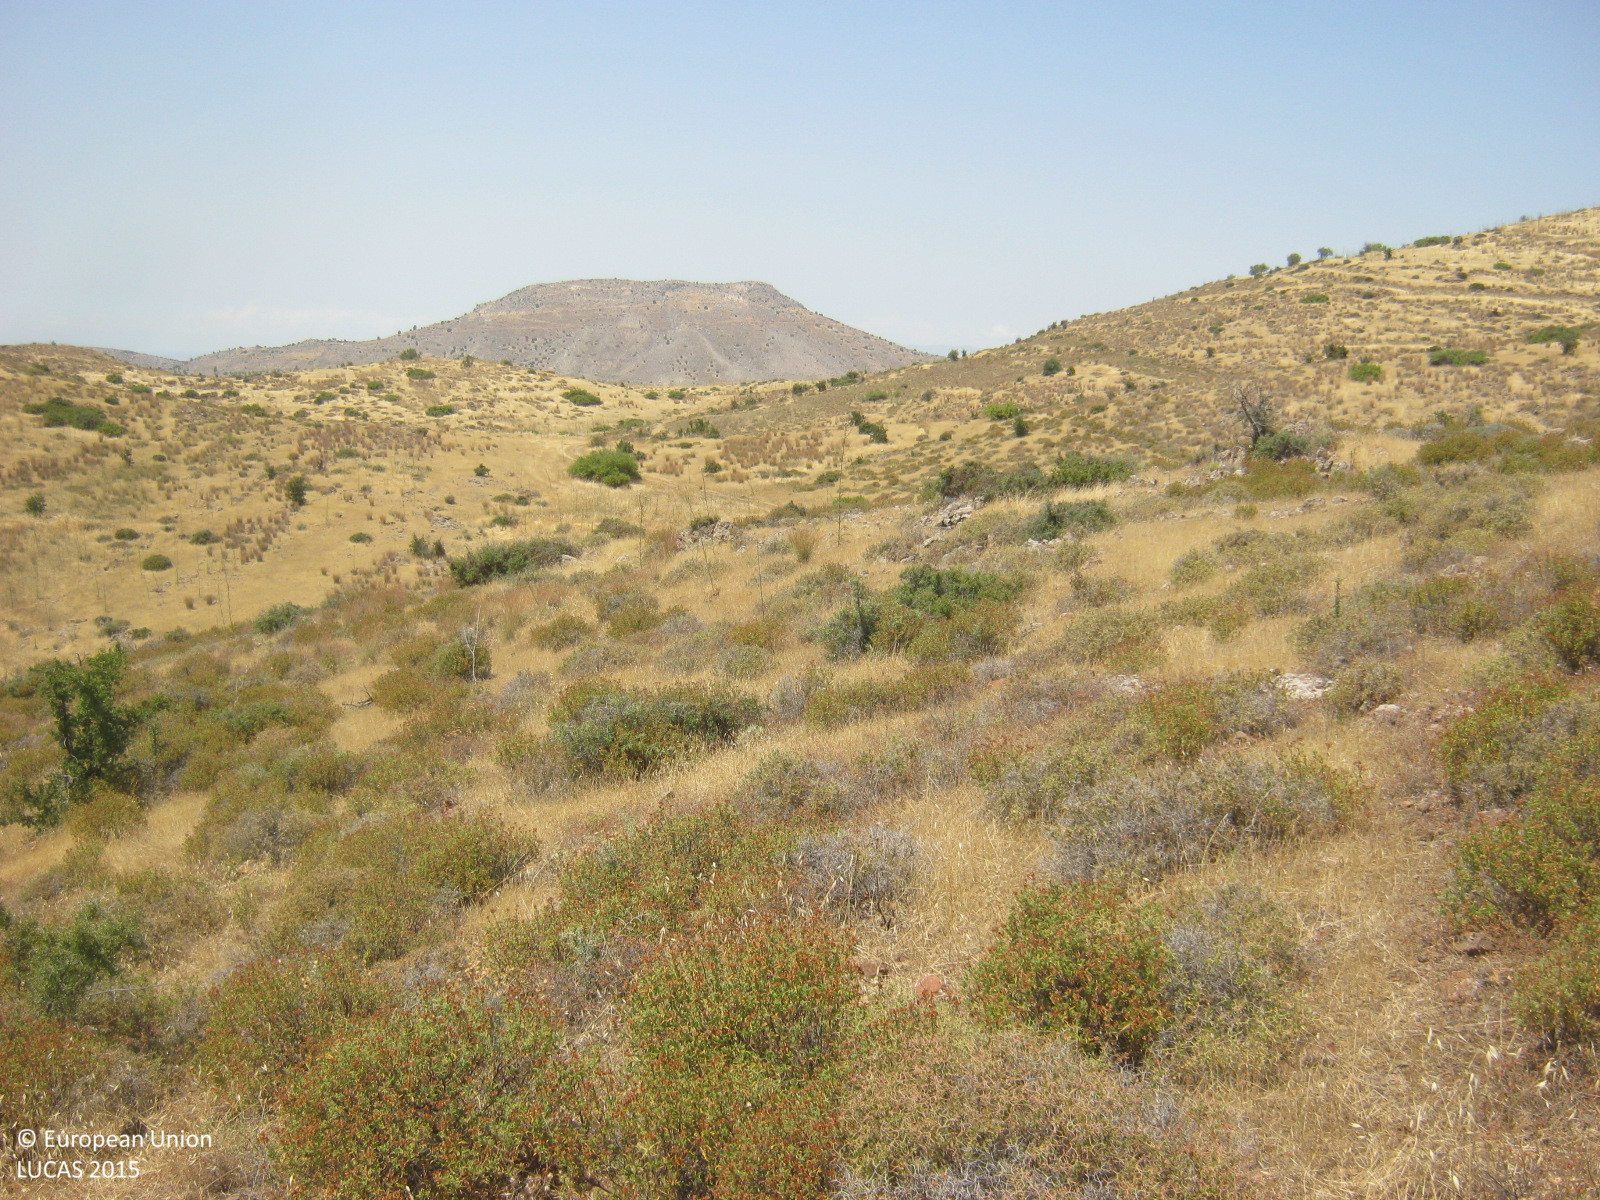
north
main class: Shrubland
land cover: Shrubland without tree cover
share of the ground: 50 - 75 %
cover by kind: shrubs 70 %, herbaceous plants 30 %
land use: Semi-natural and natural areas not in use
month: June
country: CY
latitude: 35.0206
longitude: 33.1402
